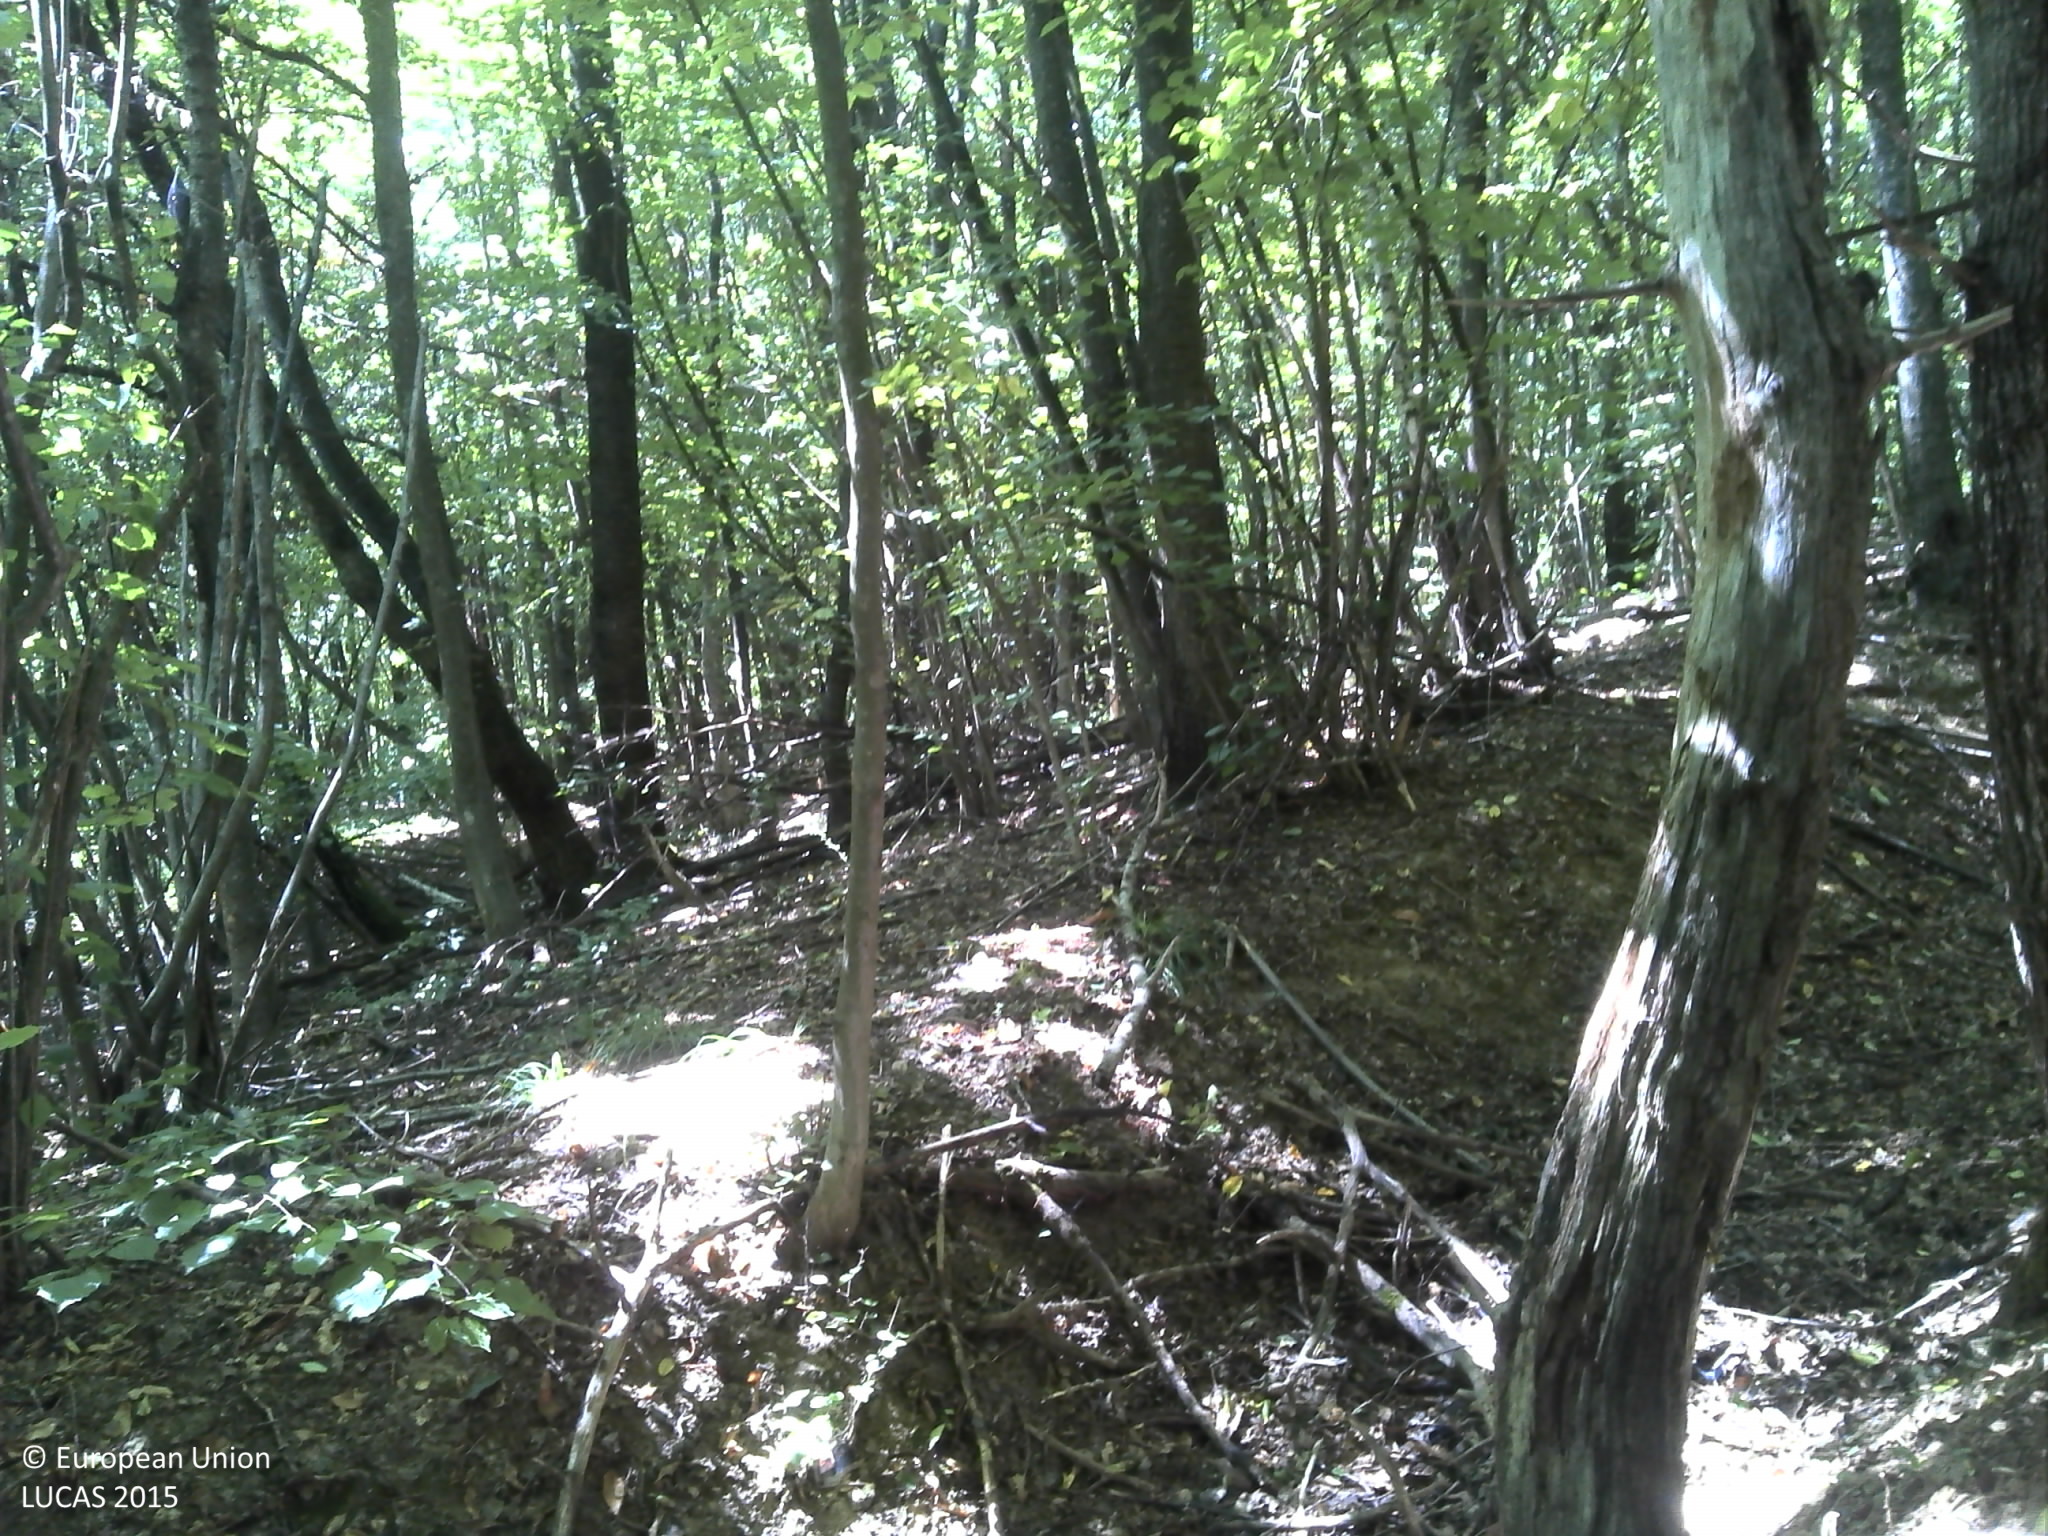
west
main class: Woodland
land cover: Broadleaved woodland
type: beech forest
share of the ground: > 75 %
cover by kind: broadleaved forest trees 100 %
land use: Forestry
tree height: > 5 m
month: August
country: HR
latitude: 45.2540
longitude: 16.4321
